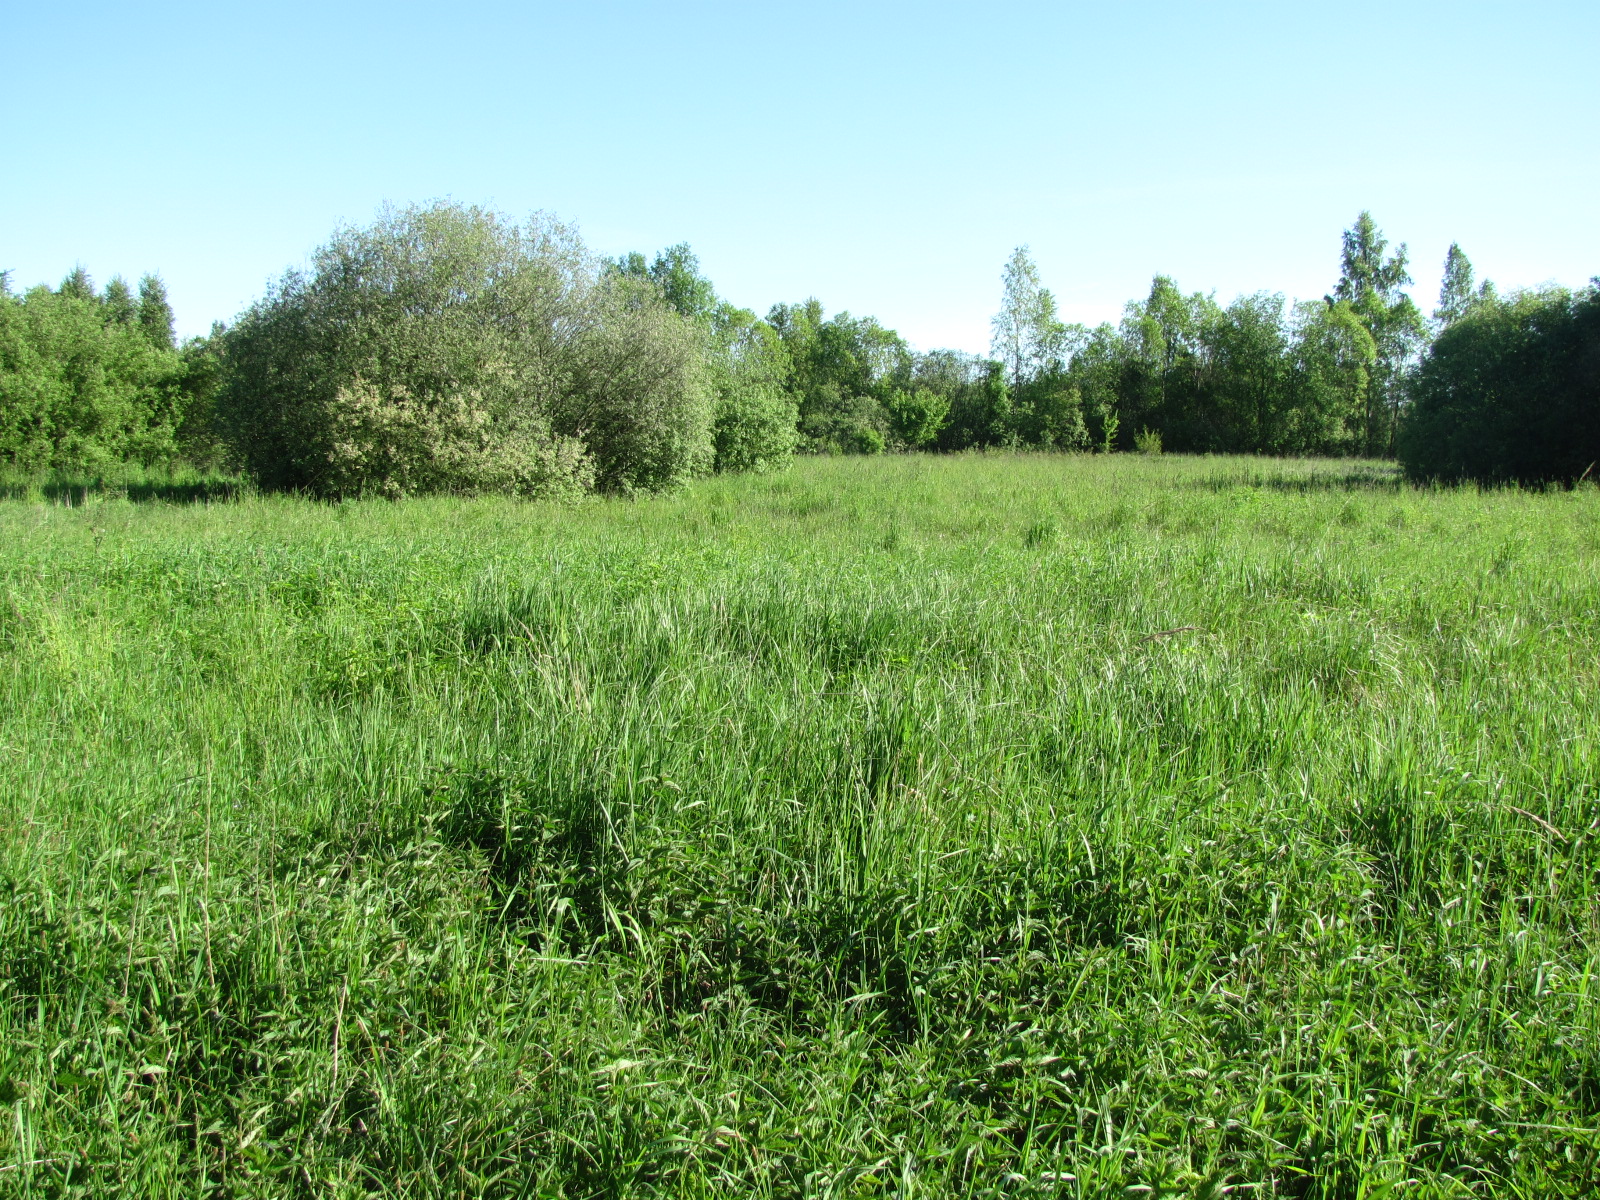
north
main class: Grassland
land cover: Spontaneously vegetated surfaces
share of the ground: > 75 %
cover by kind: herbaceous plants 100 %
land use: Fallow land
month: June
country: LV
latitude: 56.5564
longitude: 24.2612
